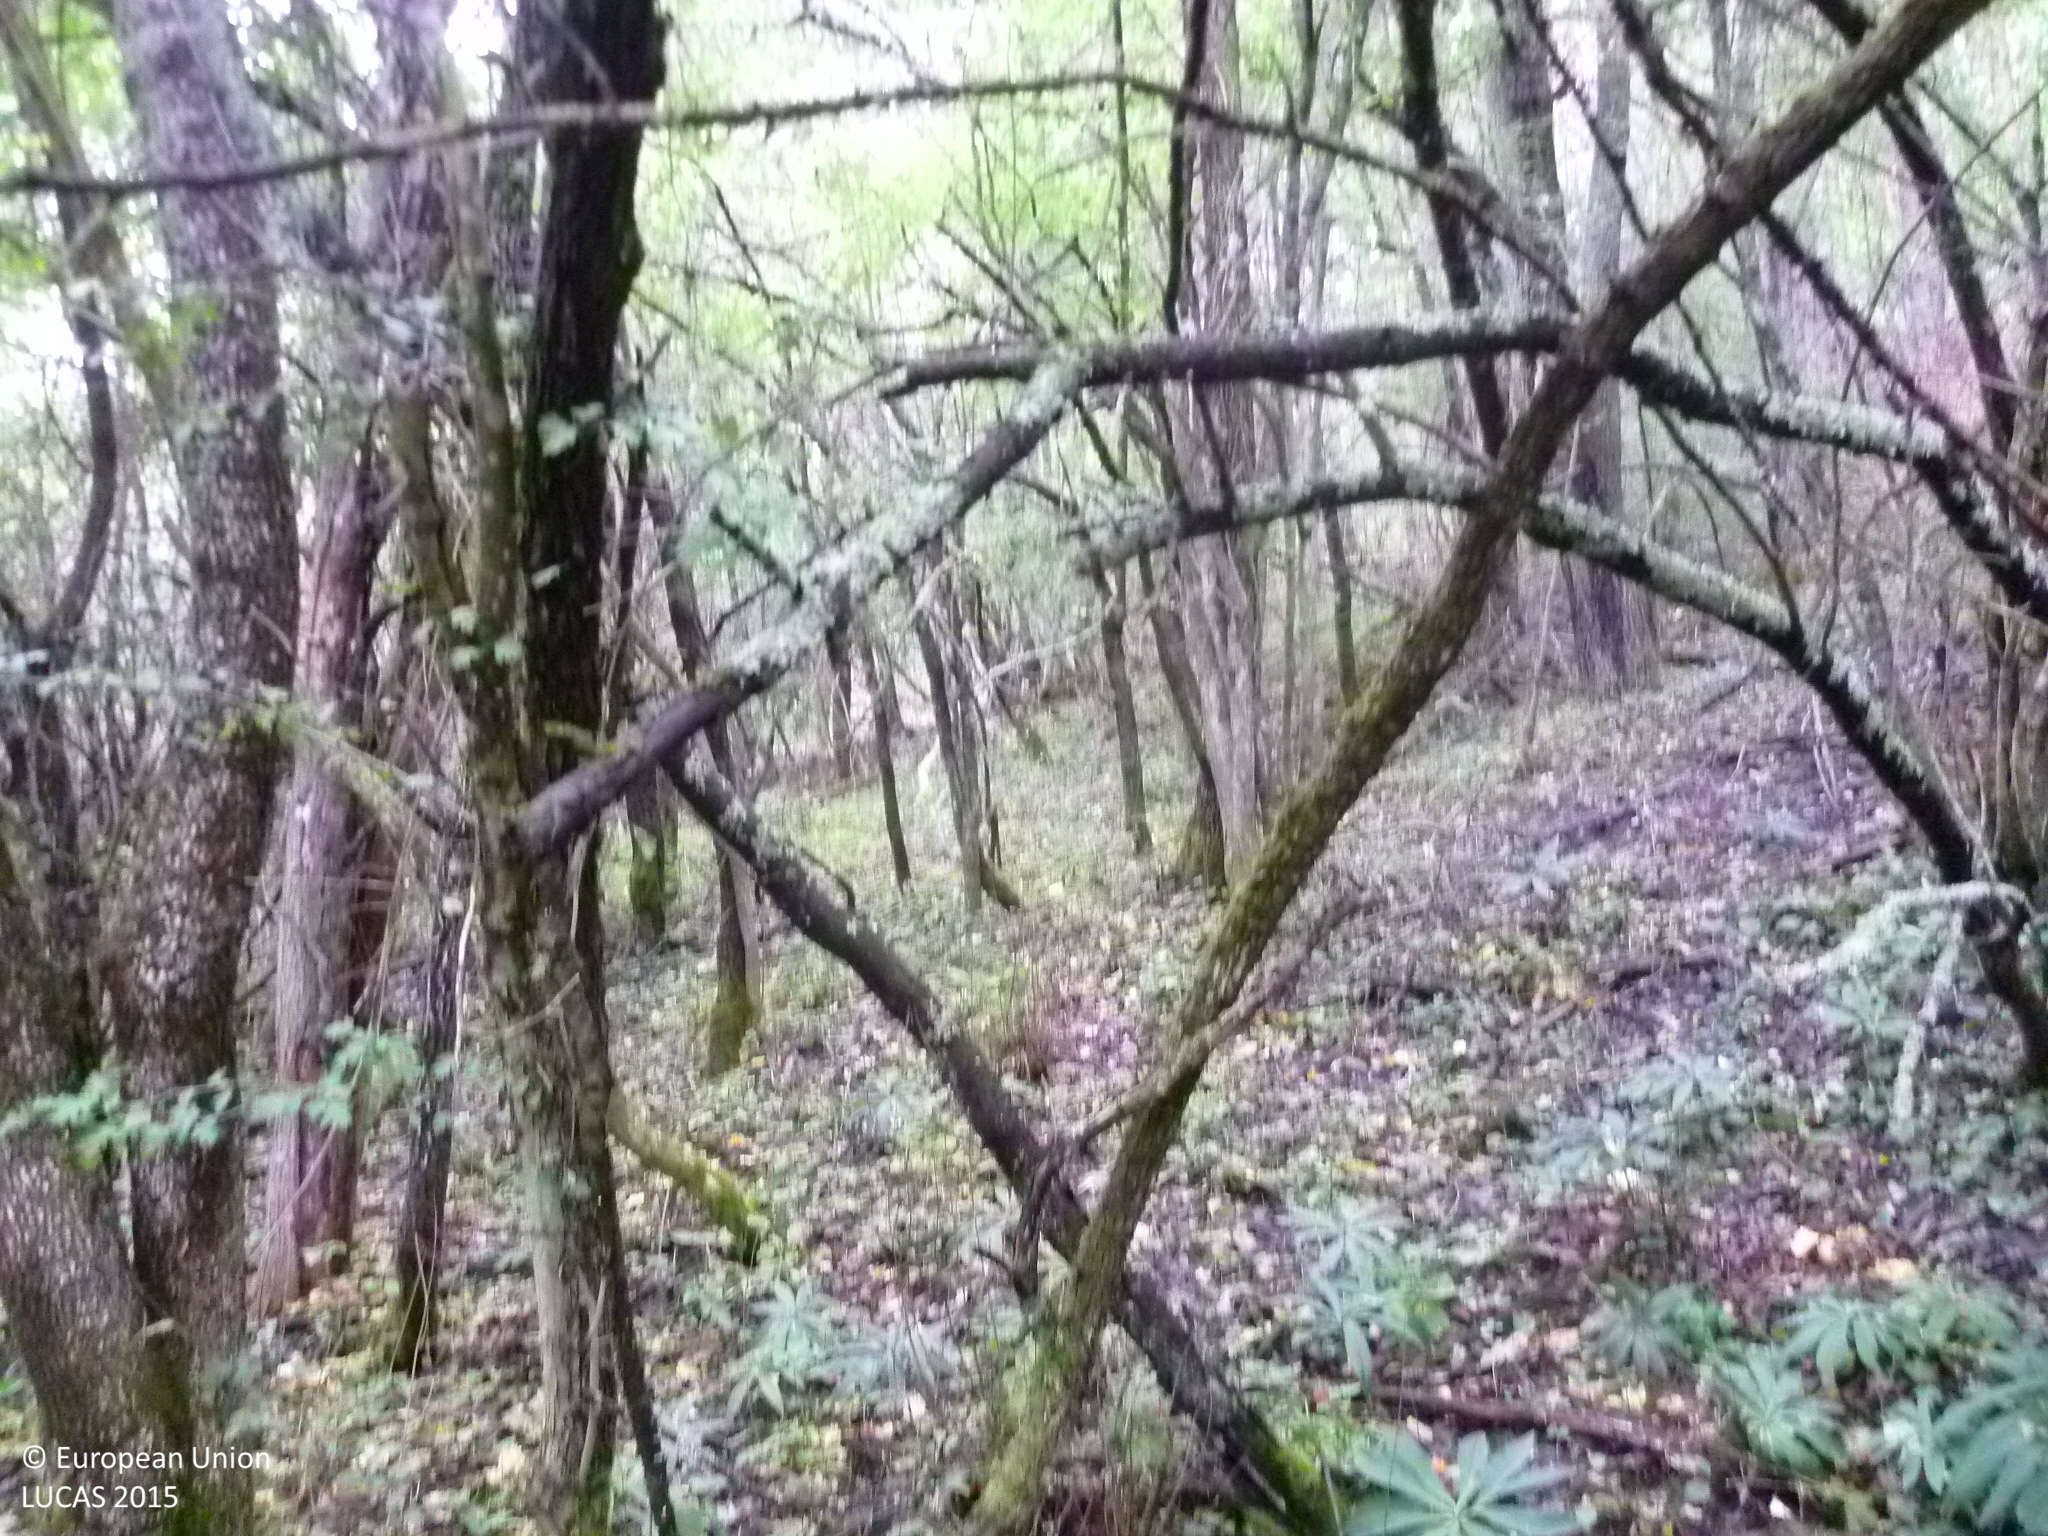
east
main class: Woodland
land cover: Broadleaved woodland
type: mesophytic deciduous forest
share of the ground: > 75 %
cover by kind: broadleaved forest trees 85 %, herbaceous plants 15 %
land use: Forestry
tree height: > 5 m
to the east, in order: Broadleaved woodland; Rivers and streams; Broadleaved woodland; Rivers and streams; Broadleaved woodland
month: September
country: BG
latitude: 42.5950
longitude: 22.7363
